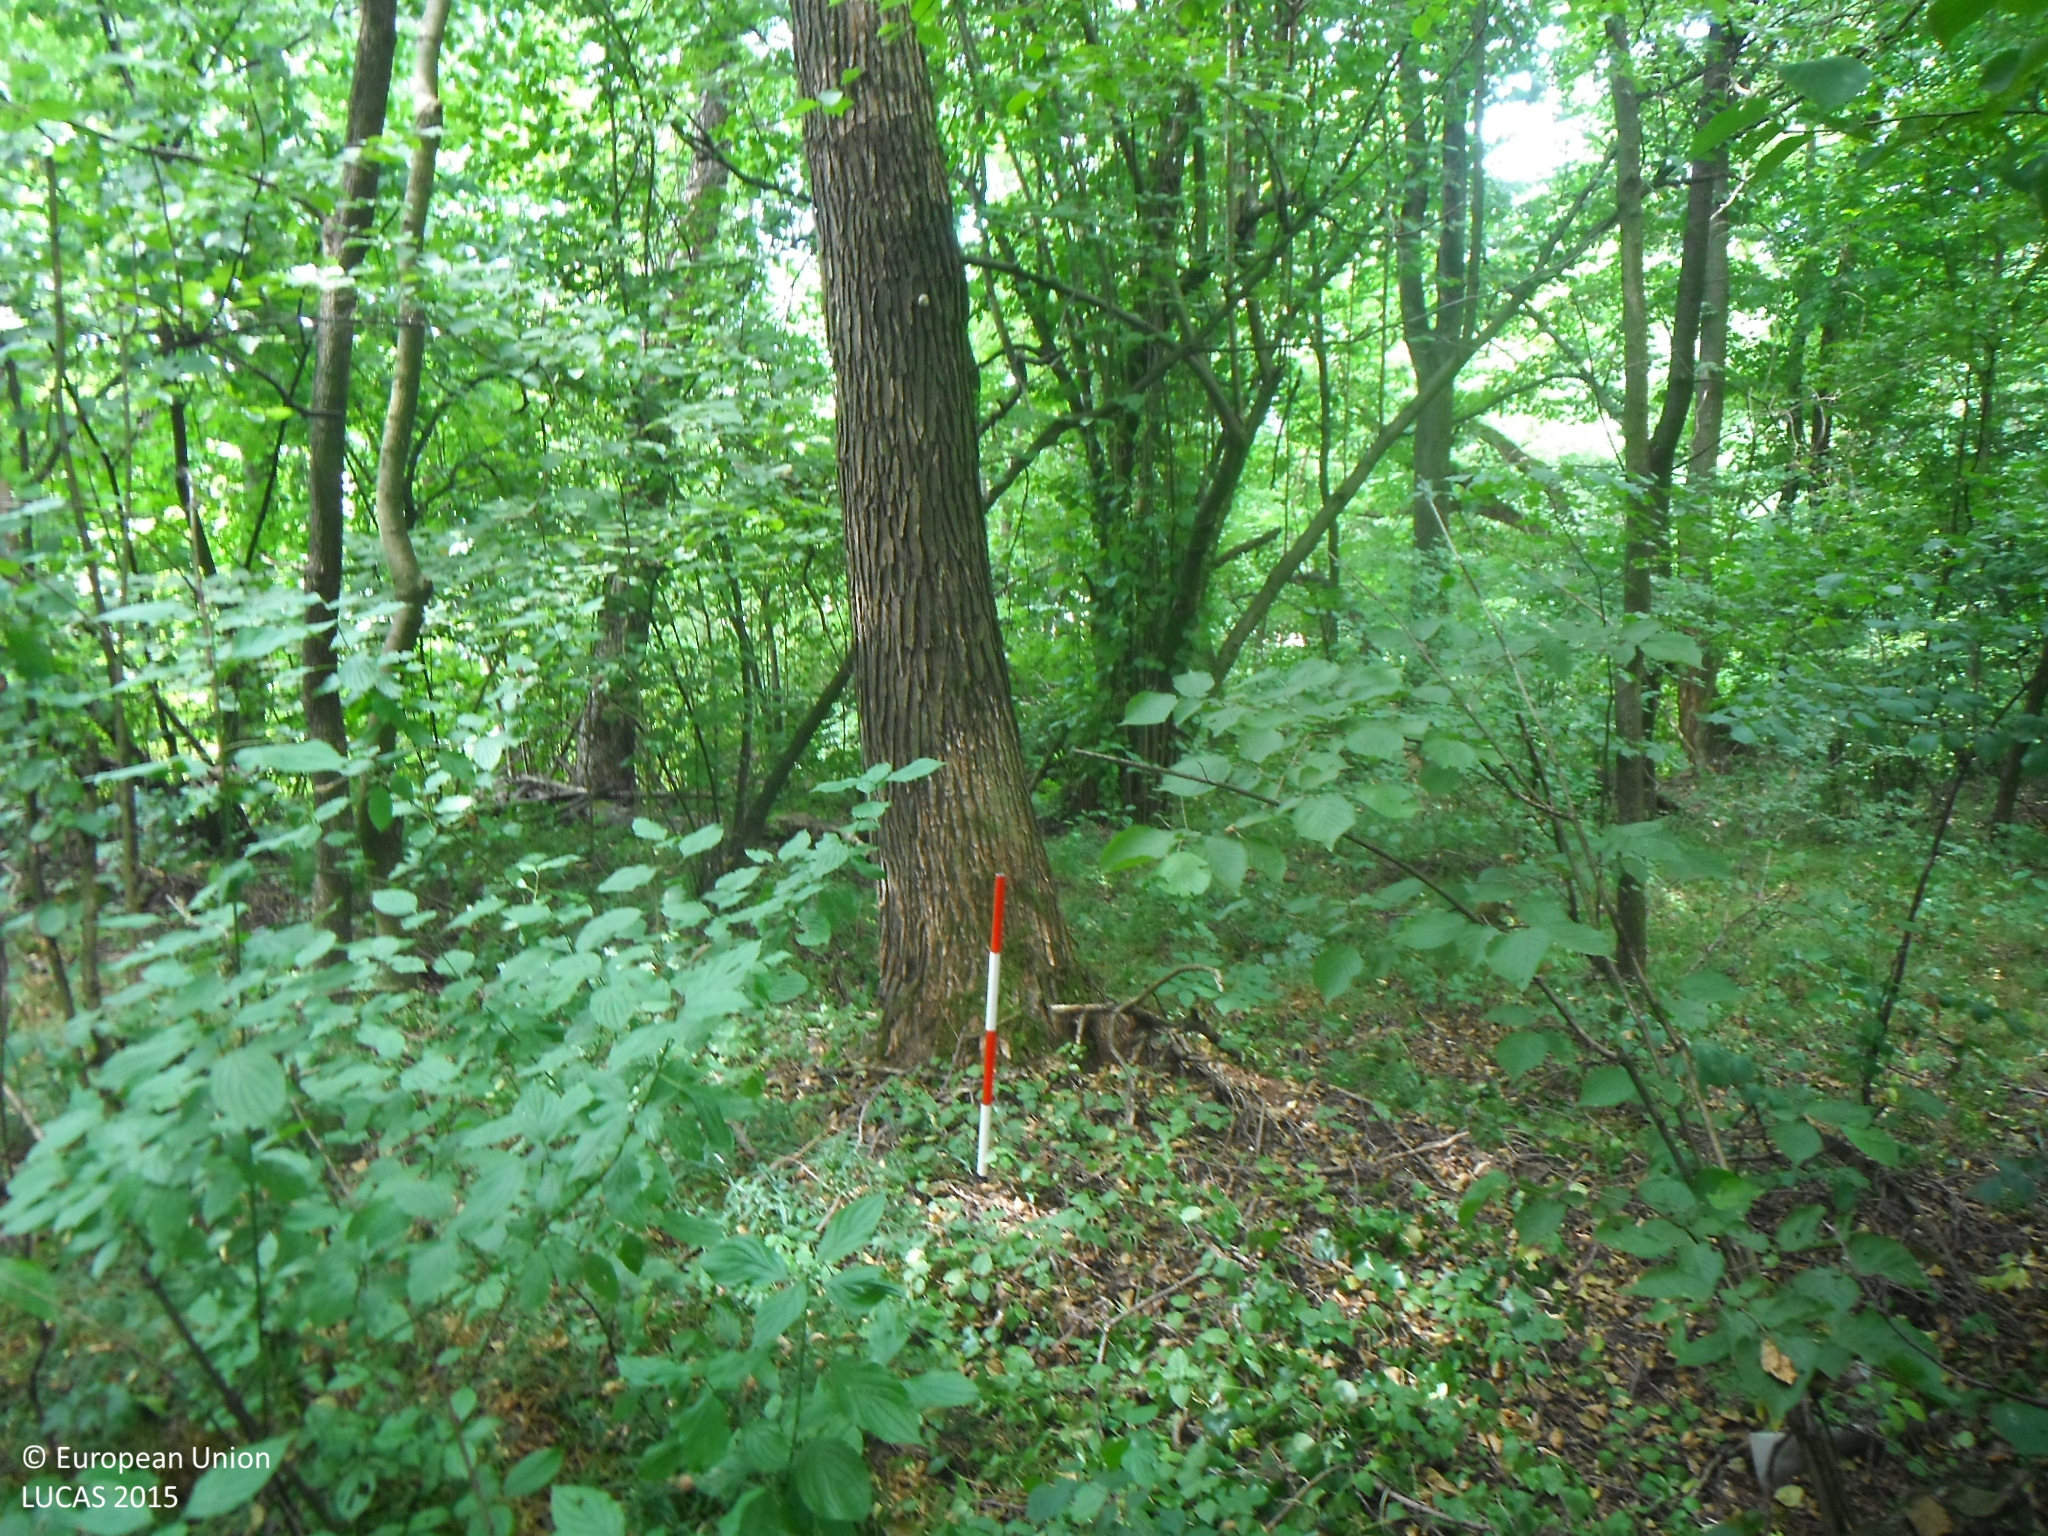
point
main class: Woodland
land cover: Broadleaved woodland
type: beech forest
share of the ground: > 75 %
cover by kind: broadleaved forest trees 100 %
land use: Semi-natural and natural areas not in use
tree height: > 5 m
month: July
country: SK
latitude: 48.9119
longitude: 21.9944
